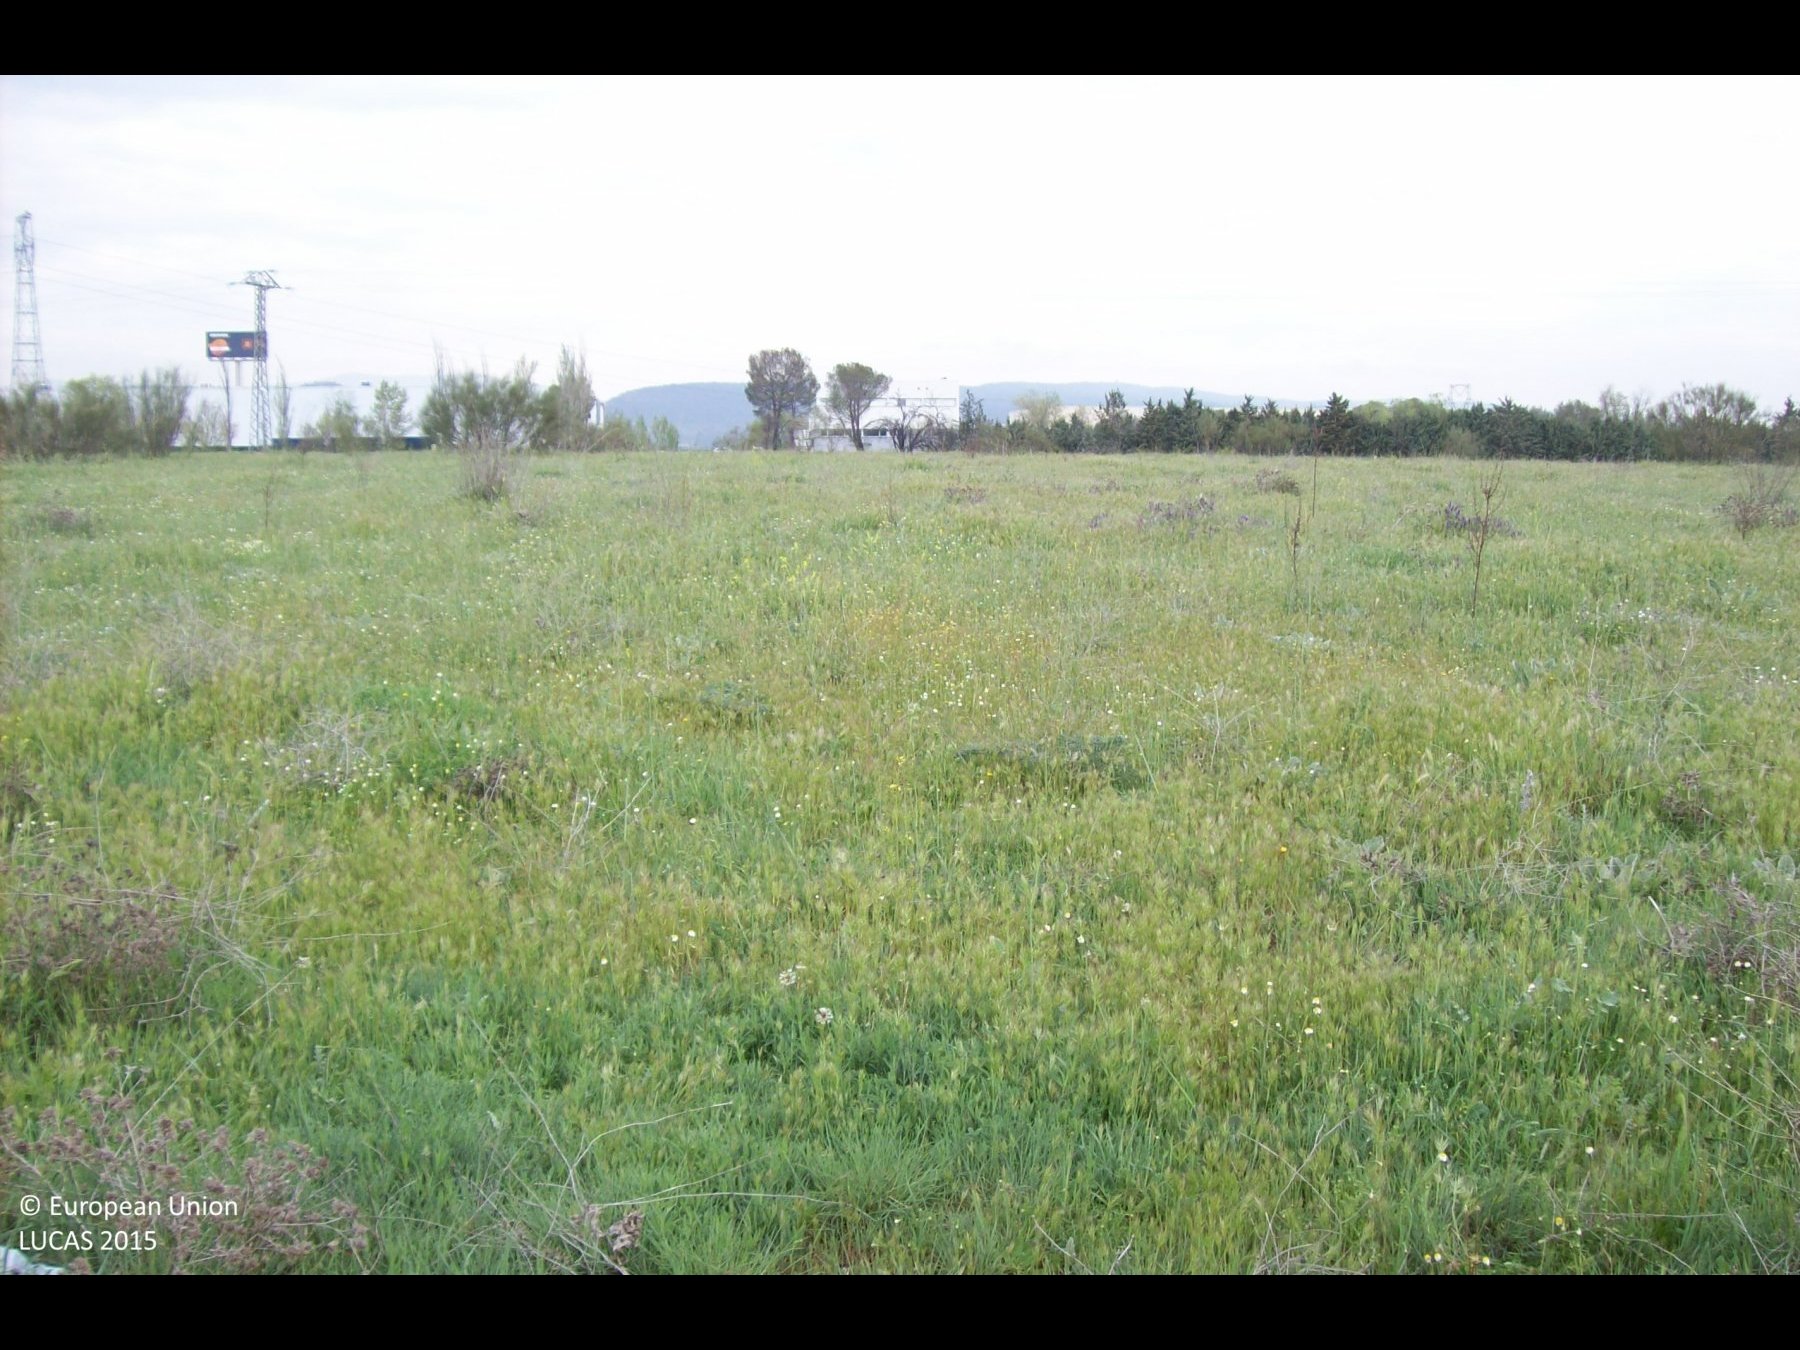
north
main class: Grassland
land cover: Grassland without tree/shrub cover
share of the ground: > 75 %
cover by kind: herbaceous plants 100 %
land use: Semi-natural and natural areas not in use
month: April
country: ES
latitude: 40.6696
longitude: -3.6081
